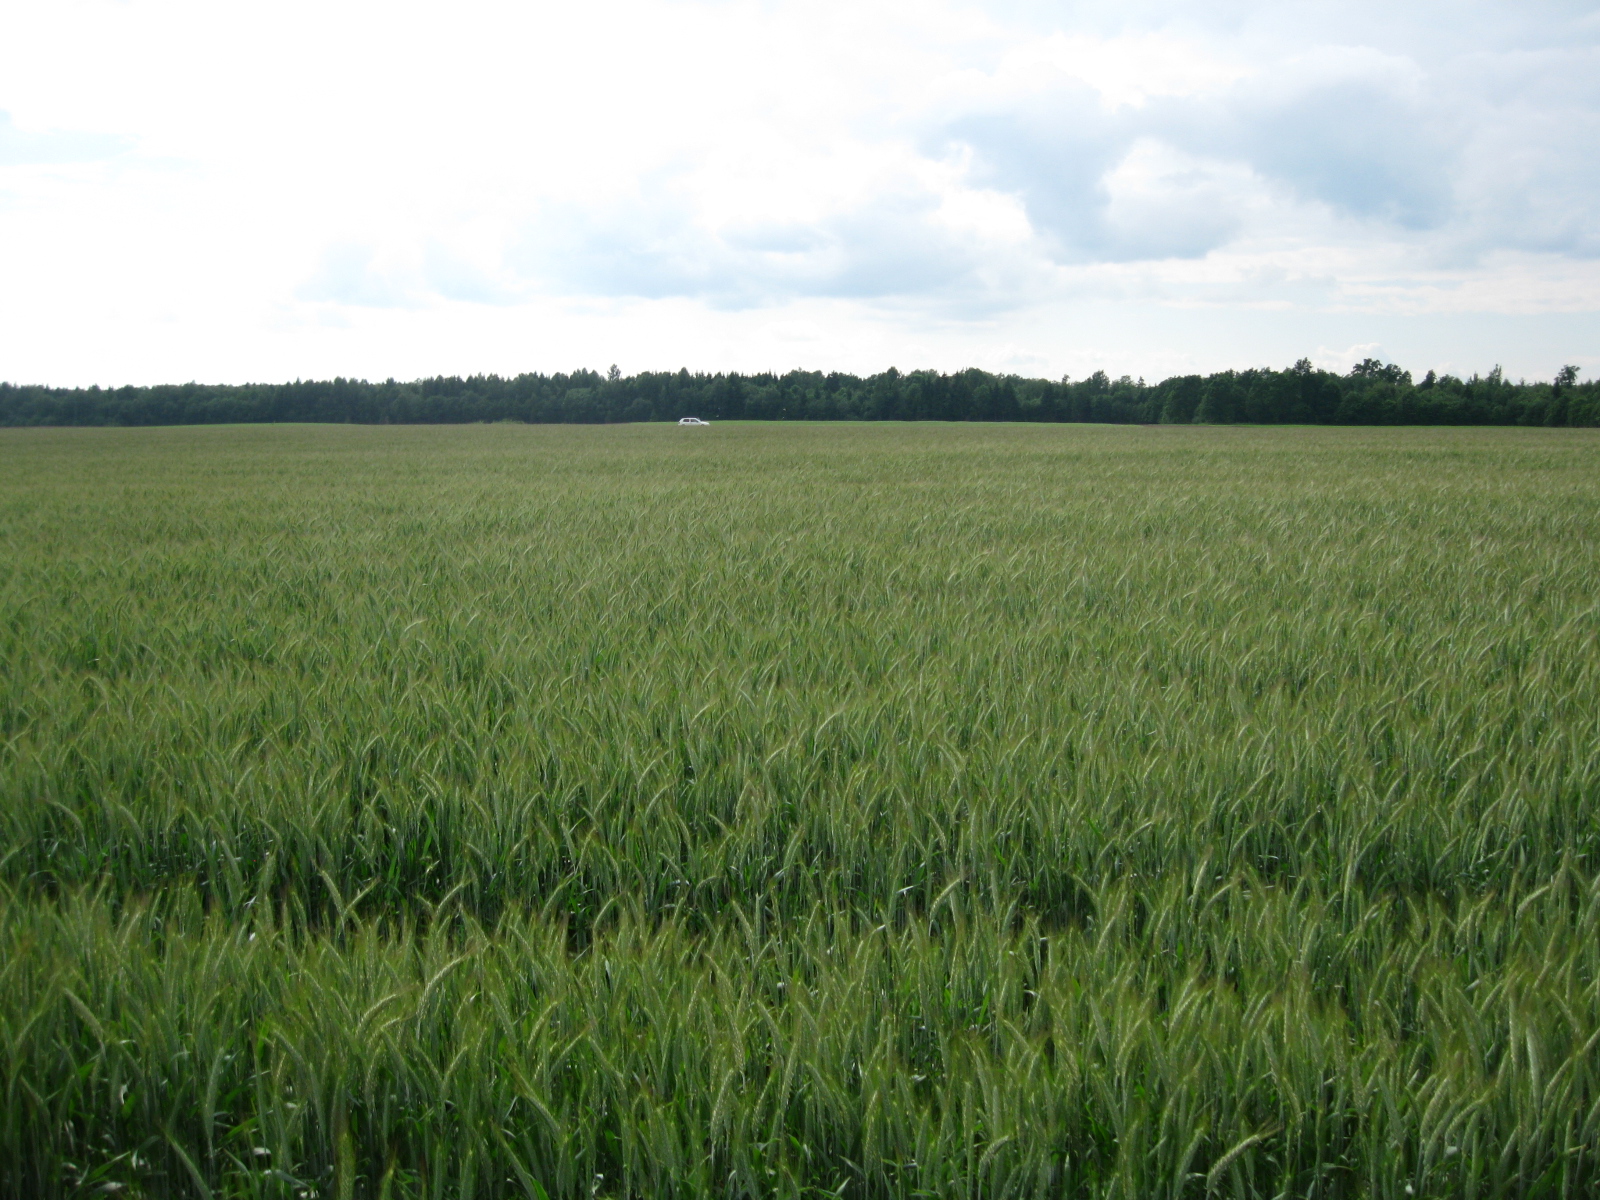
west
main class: Cropland
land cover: Triticale
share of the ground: > 75 %
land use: Agriculture (excluding fallow land and kitchen gardens)
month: June
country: LT
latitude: 55.6074
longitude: 23.9132
